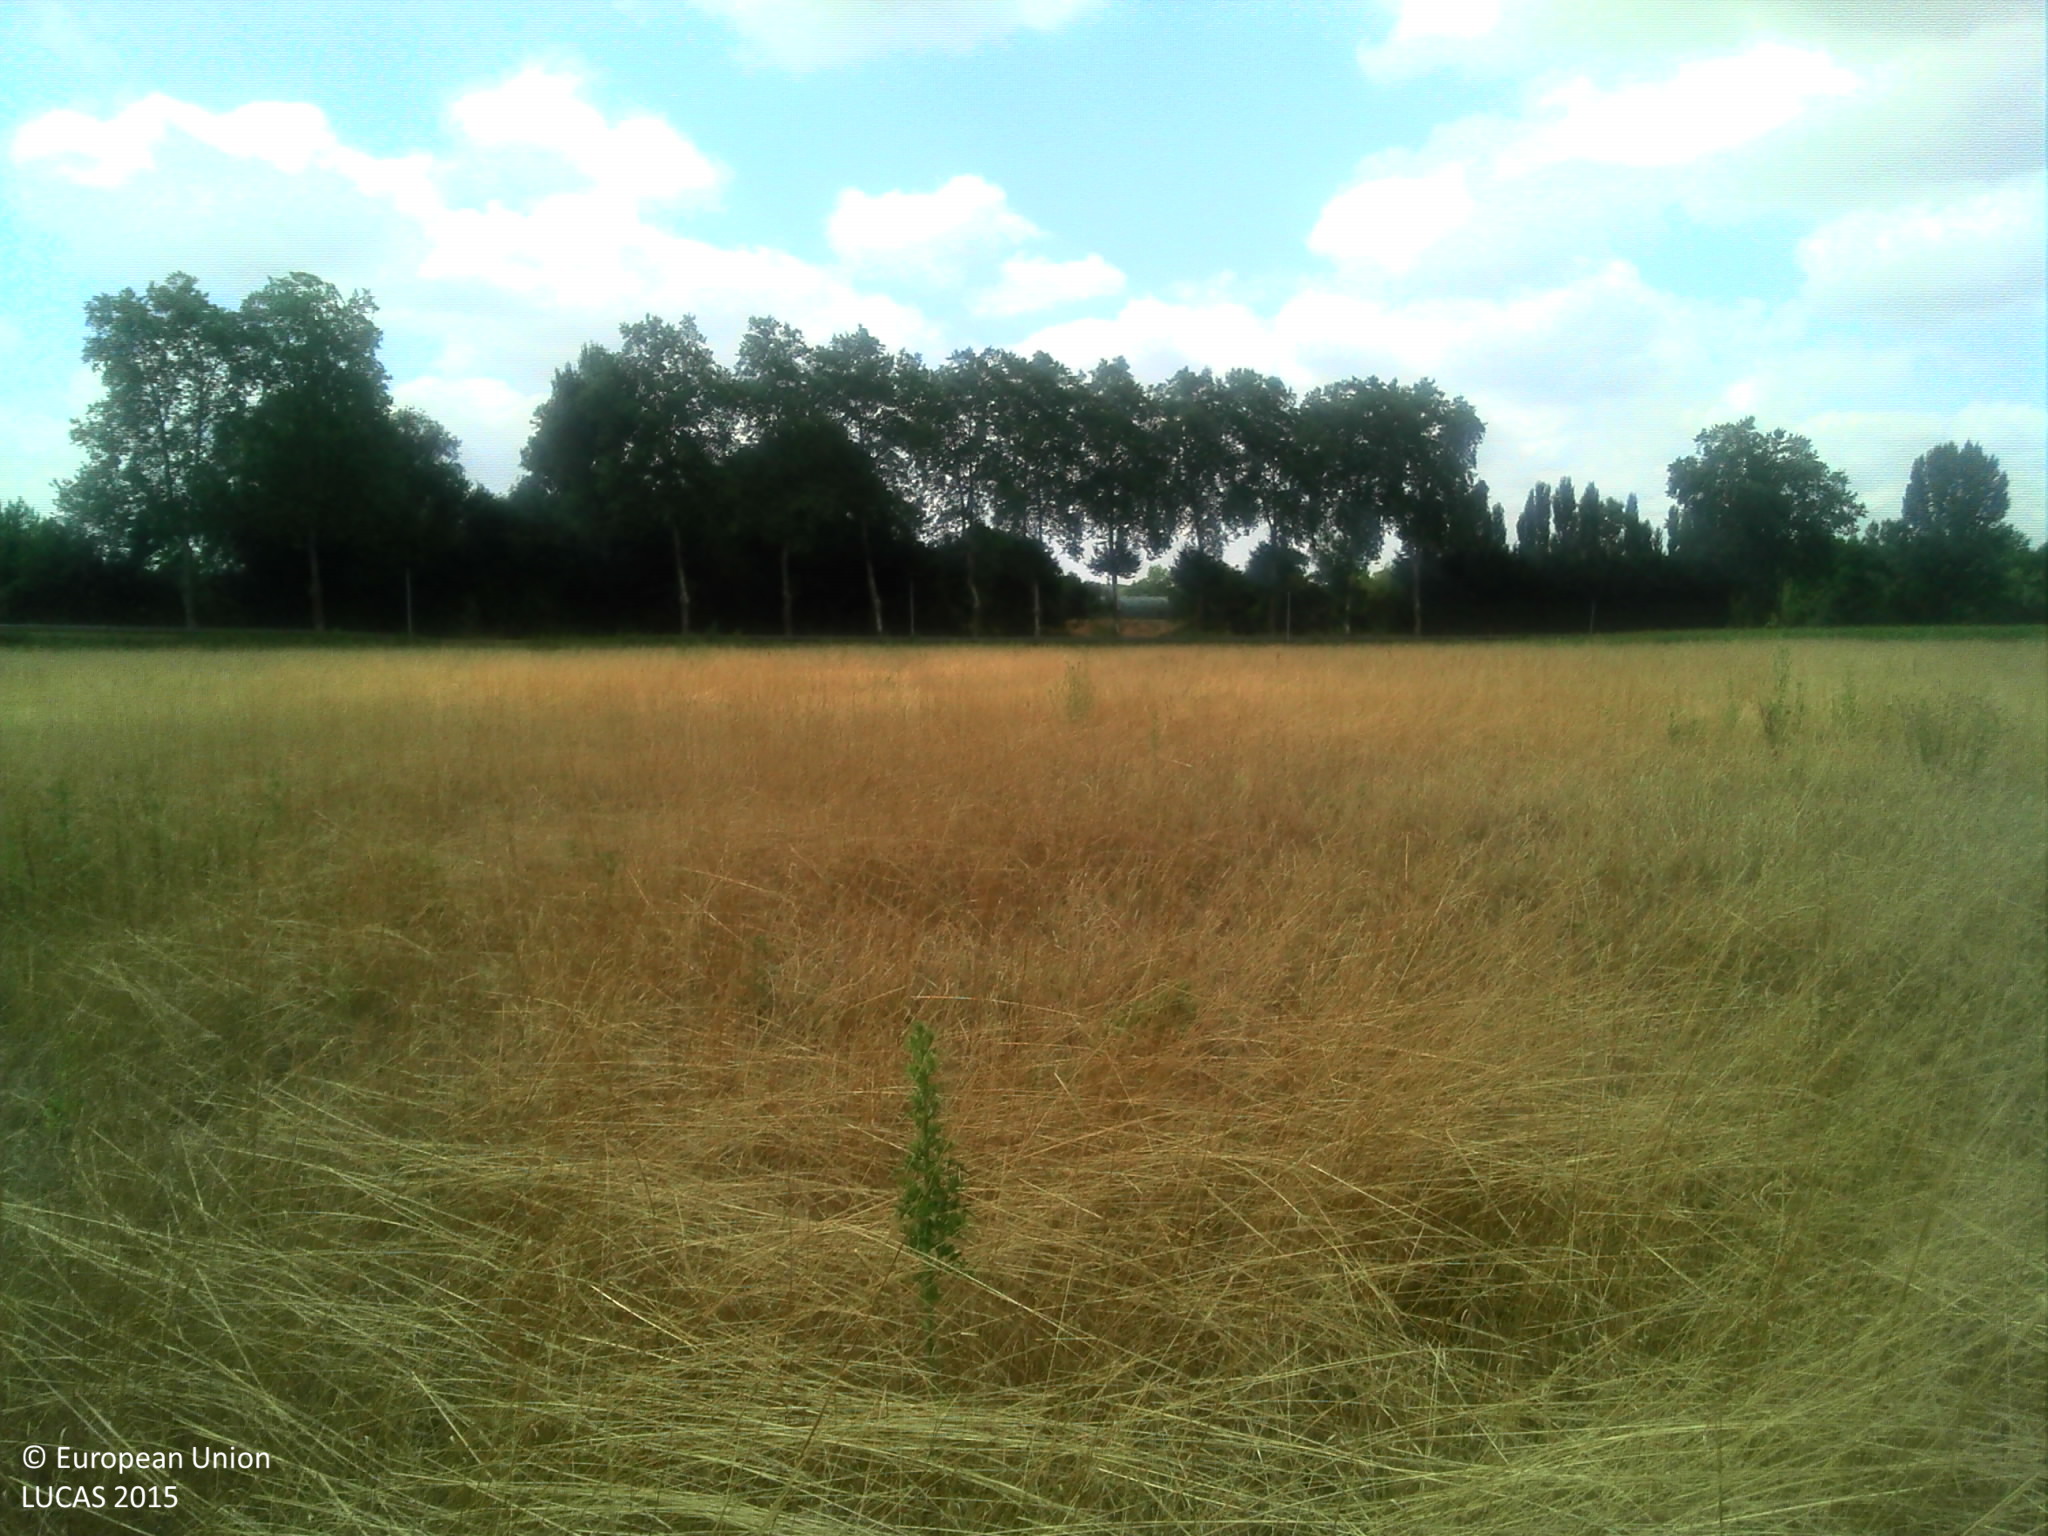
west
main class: Grassland
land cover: Grassland without tree/shrub cover
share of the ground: > 75 %
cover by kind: herbaceous plants 95 %, shrubs 5 %
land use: Agriculture (excluding fallow land and kitchen gardens)
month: July
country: FR
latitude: 43.8911
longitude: 0.6481
